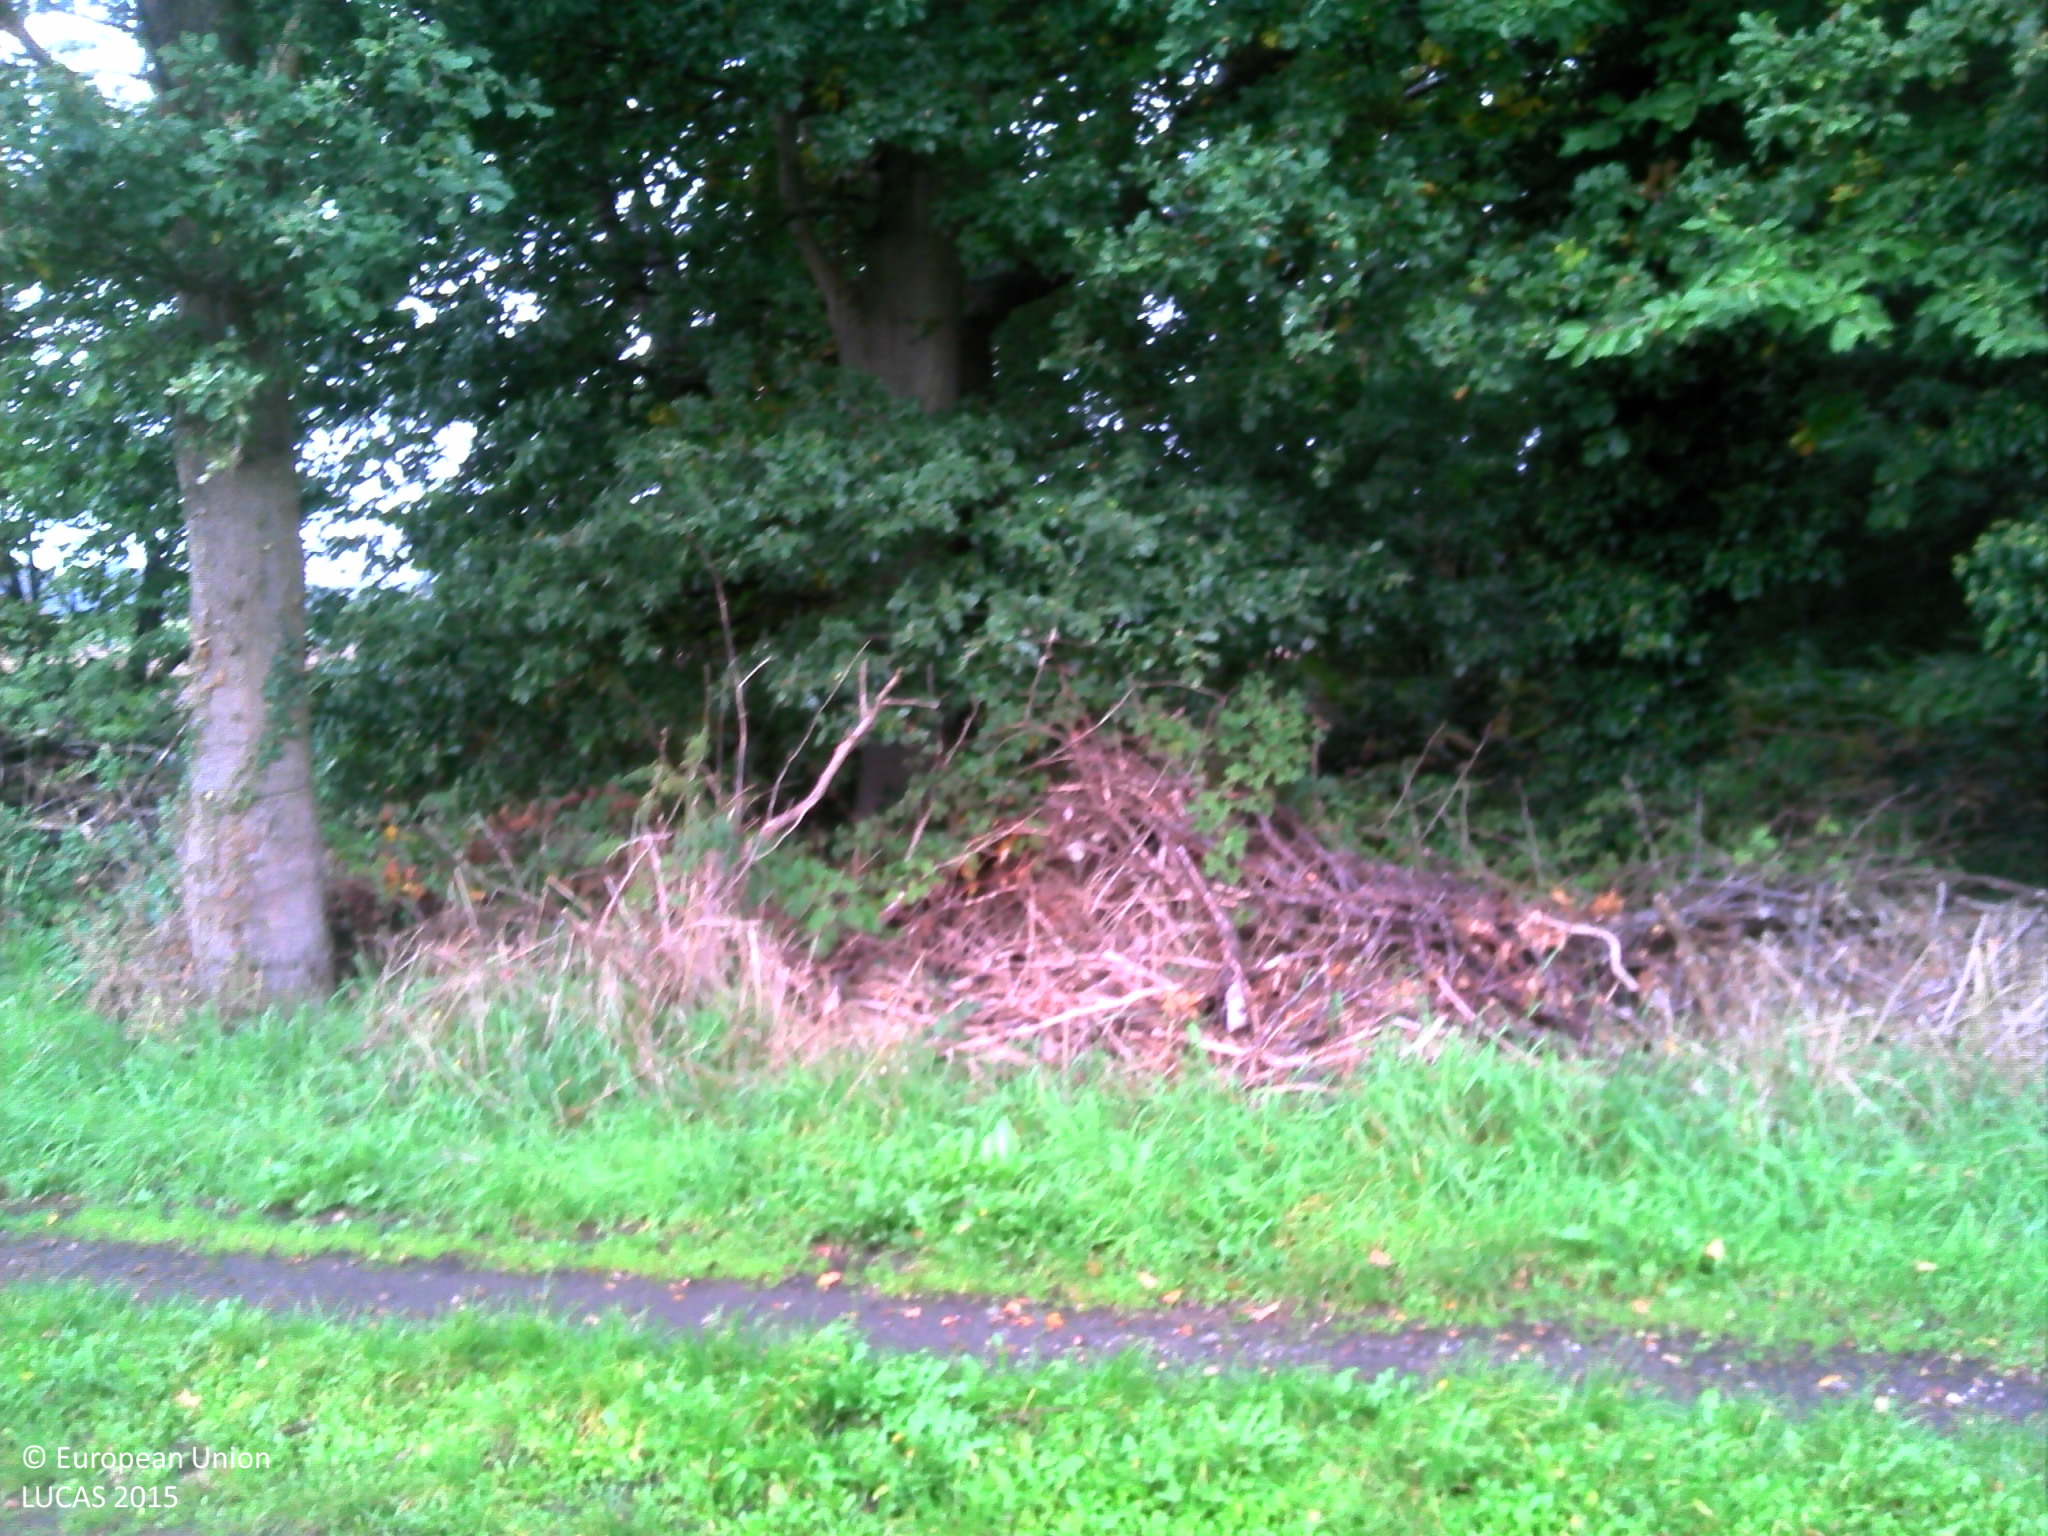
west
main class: Cropland
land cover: Maize
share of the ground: > 75 %
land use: Agriculture (excluding fallow land and kitchen gardens)
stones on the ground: < 10 %
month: October
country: BE
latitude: 51.1086
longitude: 4.7545
